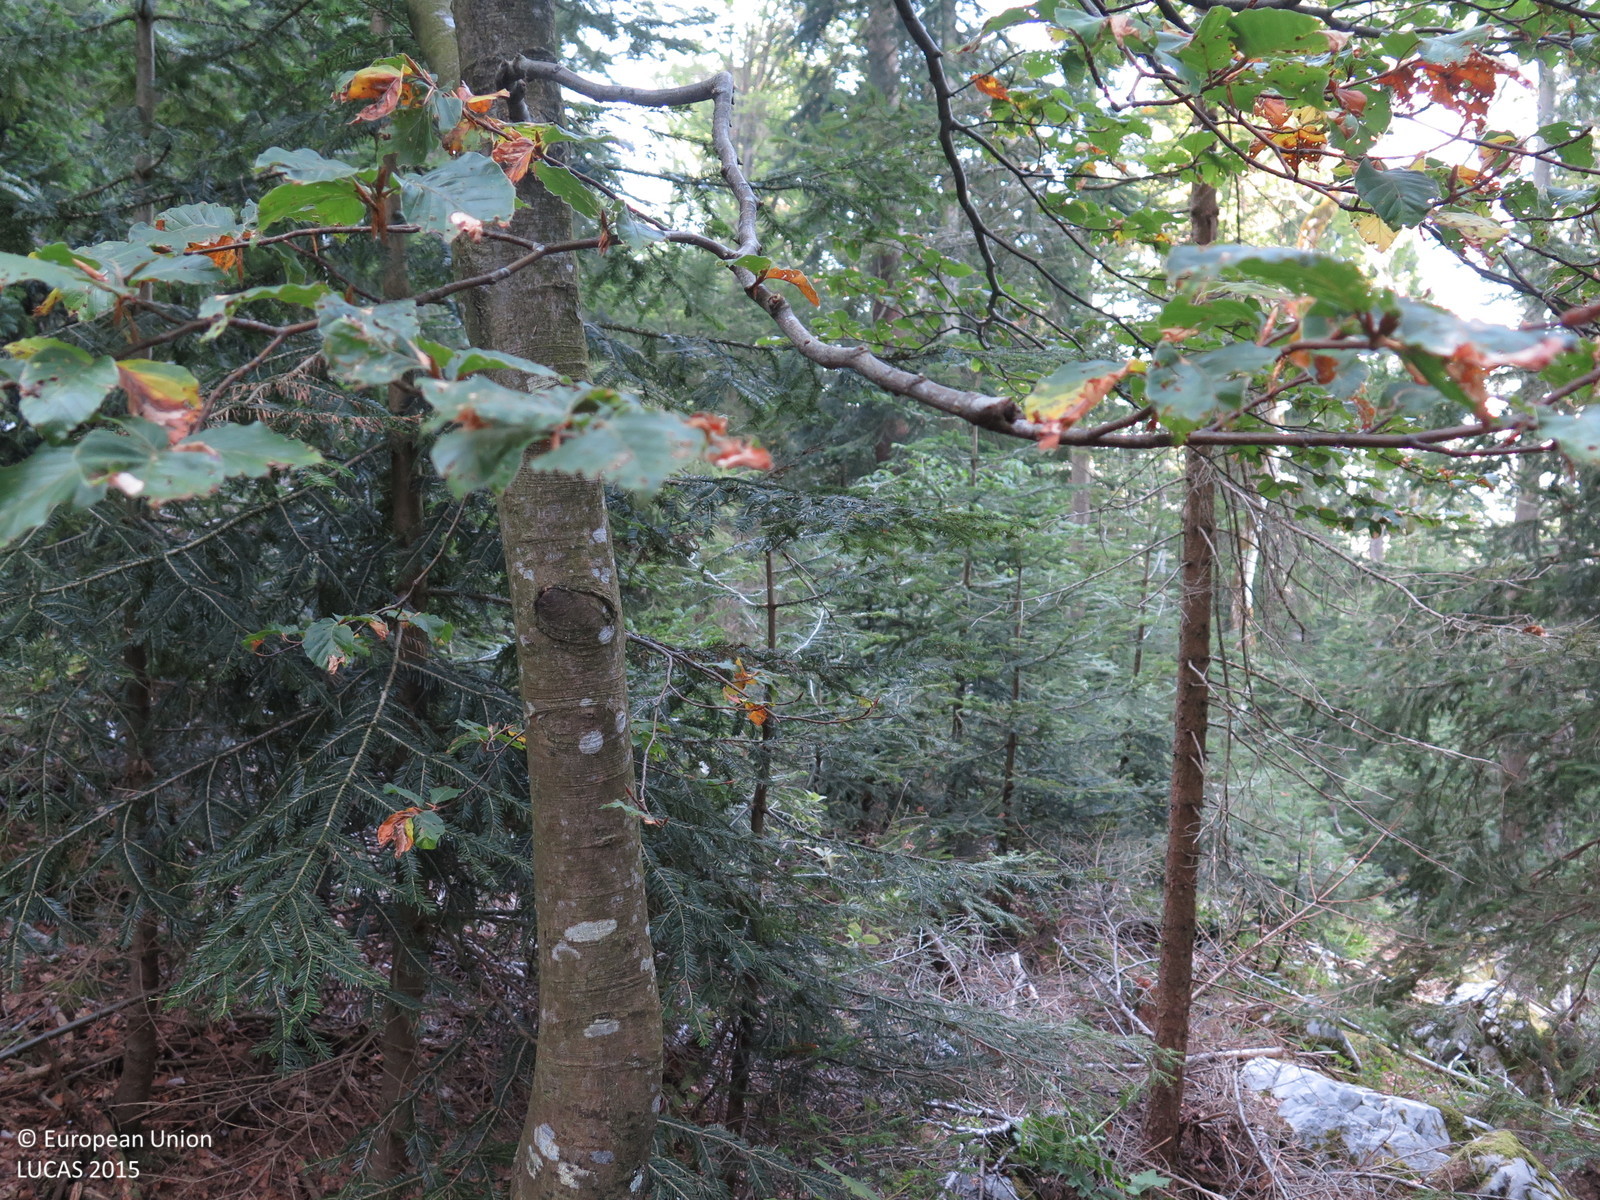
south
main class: Woodland
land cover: Other mixed woodland
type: mountainous beech forest
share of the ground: > 75 %
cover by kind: coniferous forest trees 75 %, broadleaved forest trees 25 %
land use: Forestry
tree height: > 5 m
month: August
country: HR
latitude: 45.3325
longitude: 14.9843
